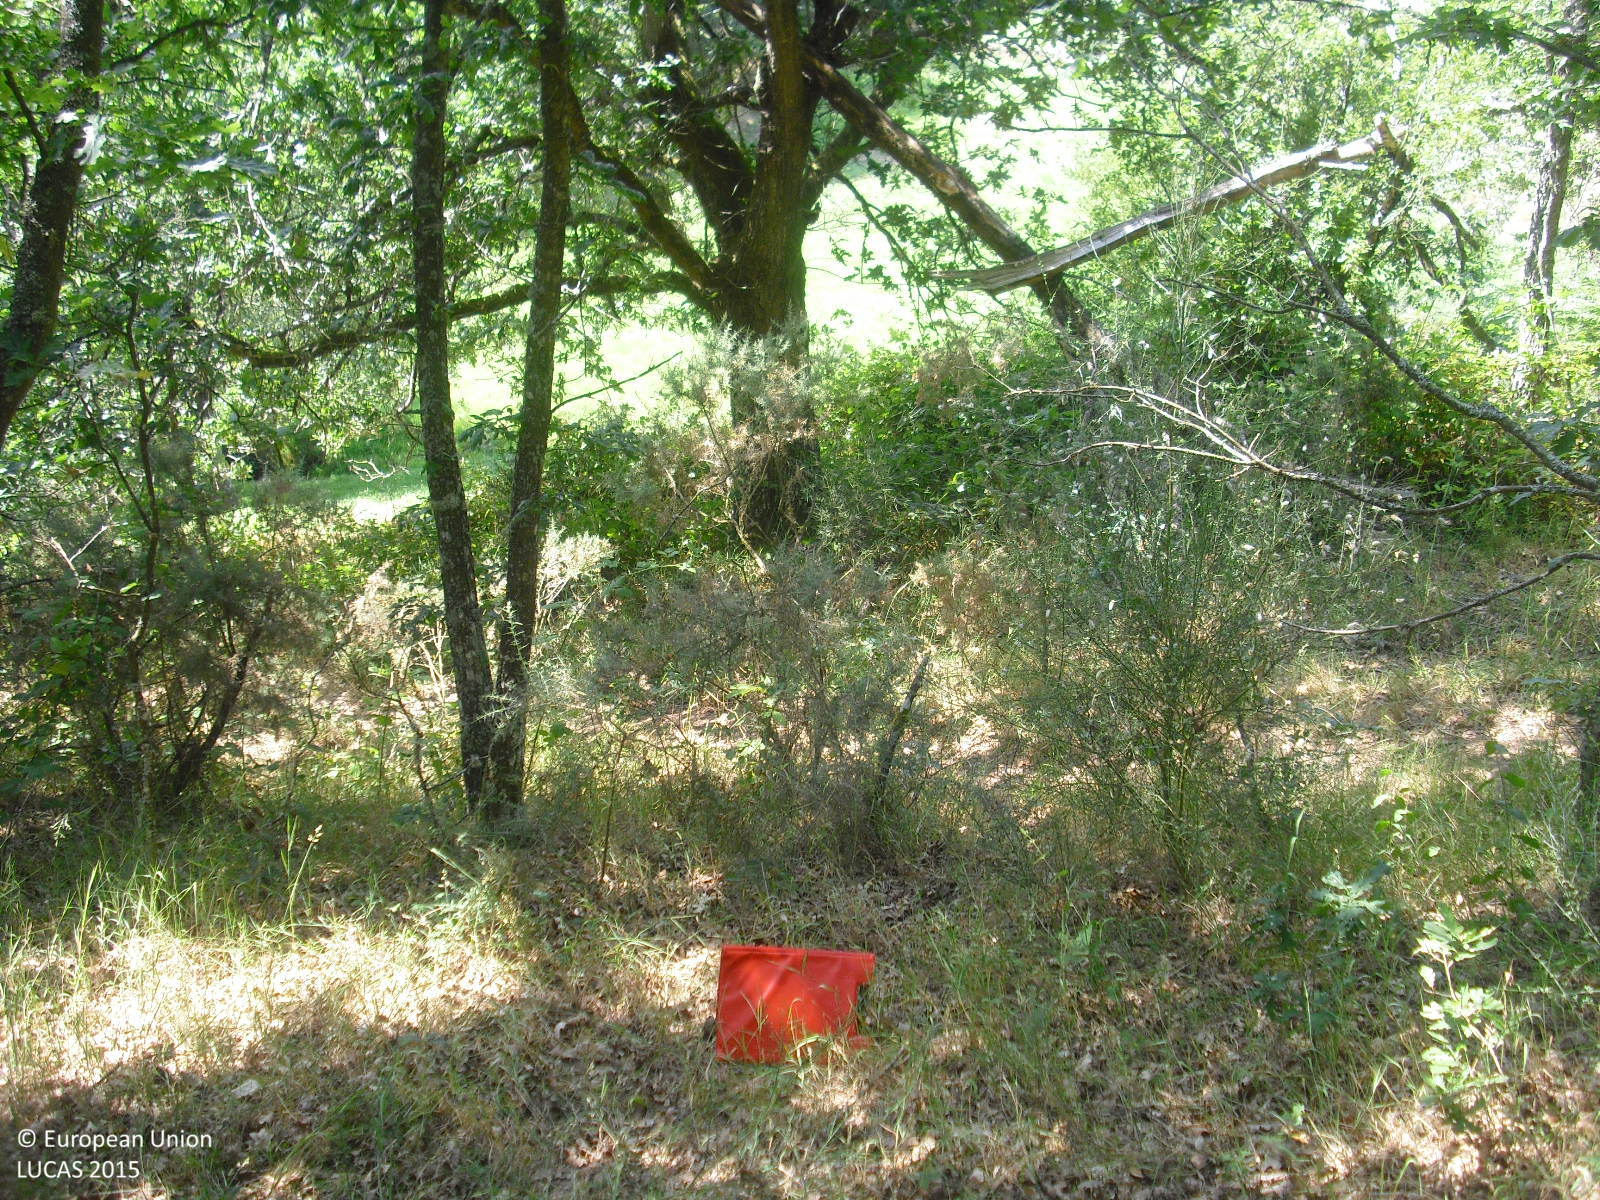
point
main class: Woodland
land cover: Broadleaved woodland
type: acidophilous oak and oak-birch forest
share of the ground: > 75 %
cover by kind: broadleaved forest trees 100 %
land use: Semi-natural and natural areas not in use
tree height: > 5 m
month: June
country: ES
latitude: 42.6441
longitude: -7.8261
